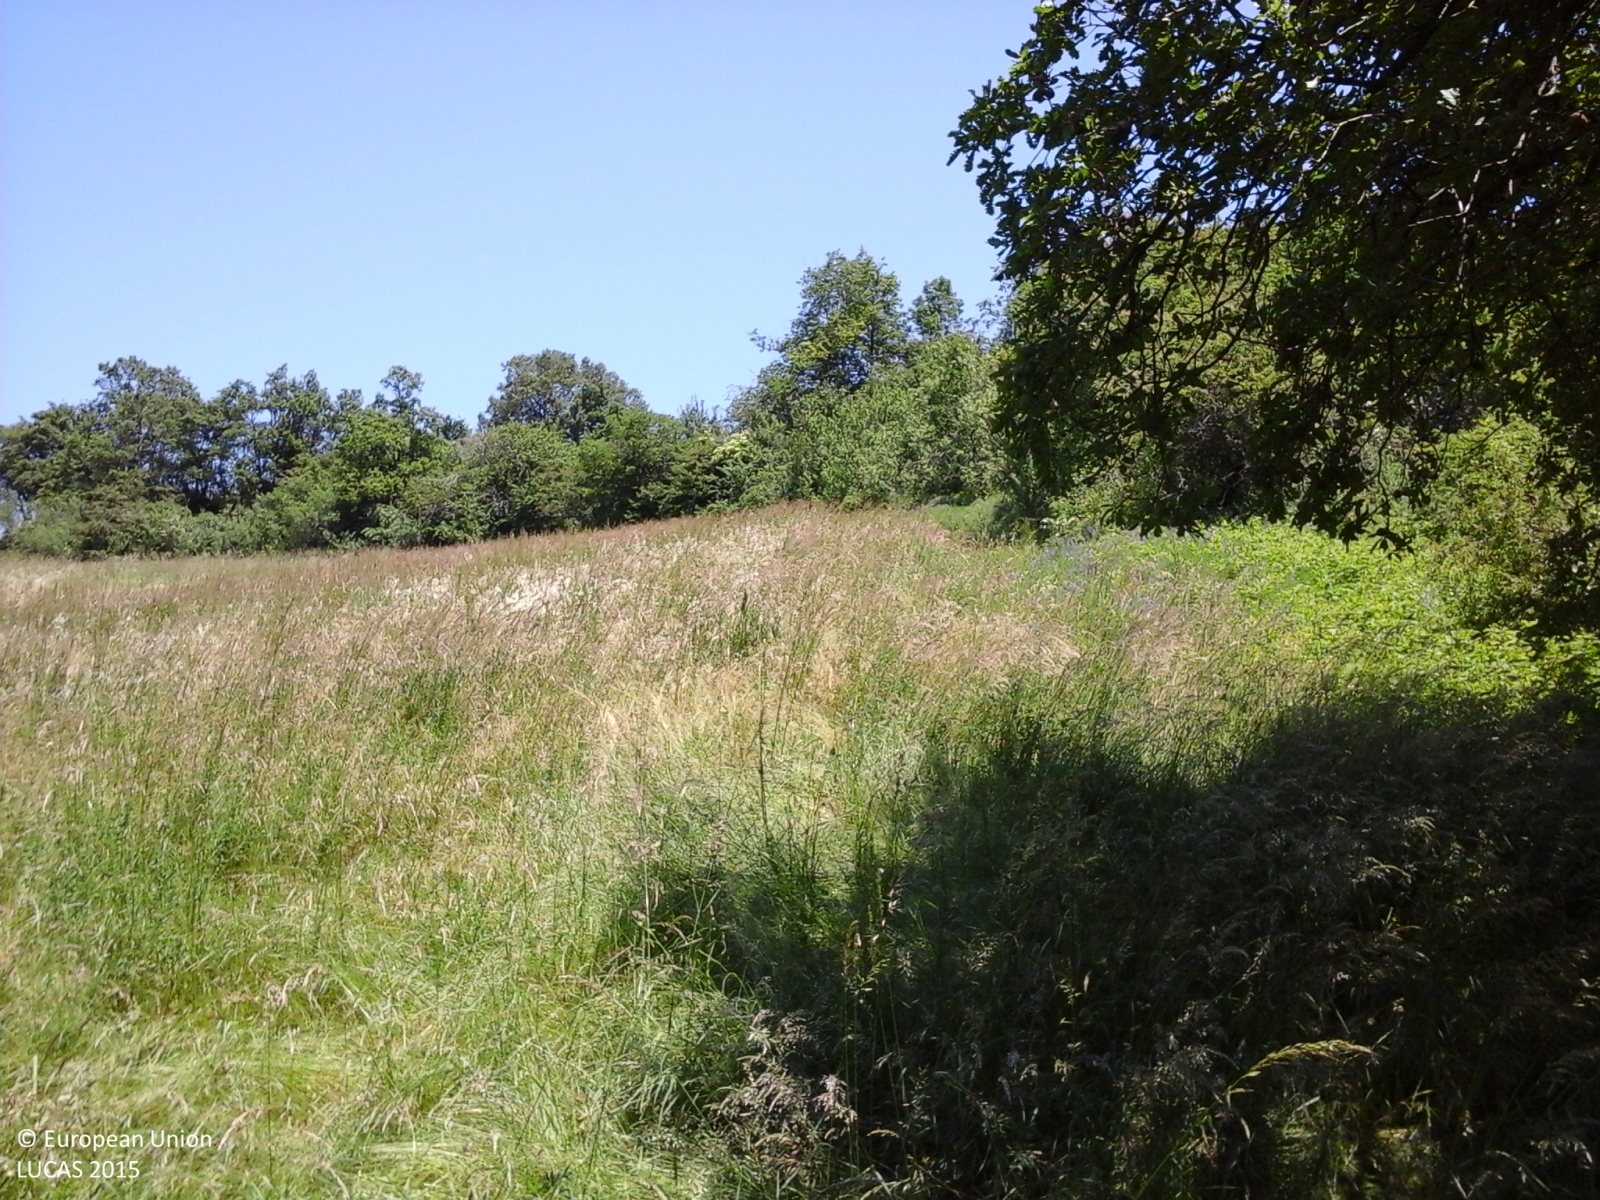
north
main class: Woodland
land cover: Broadleaved woodland
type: thermophilous deciduous forest
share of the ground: > 75 %
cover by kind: broadleaved forest trees 100 %
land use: Forestry
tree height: > 5 m
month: May
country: IT
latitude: 44.7473
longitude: 9.9118
